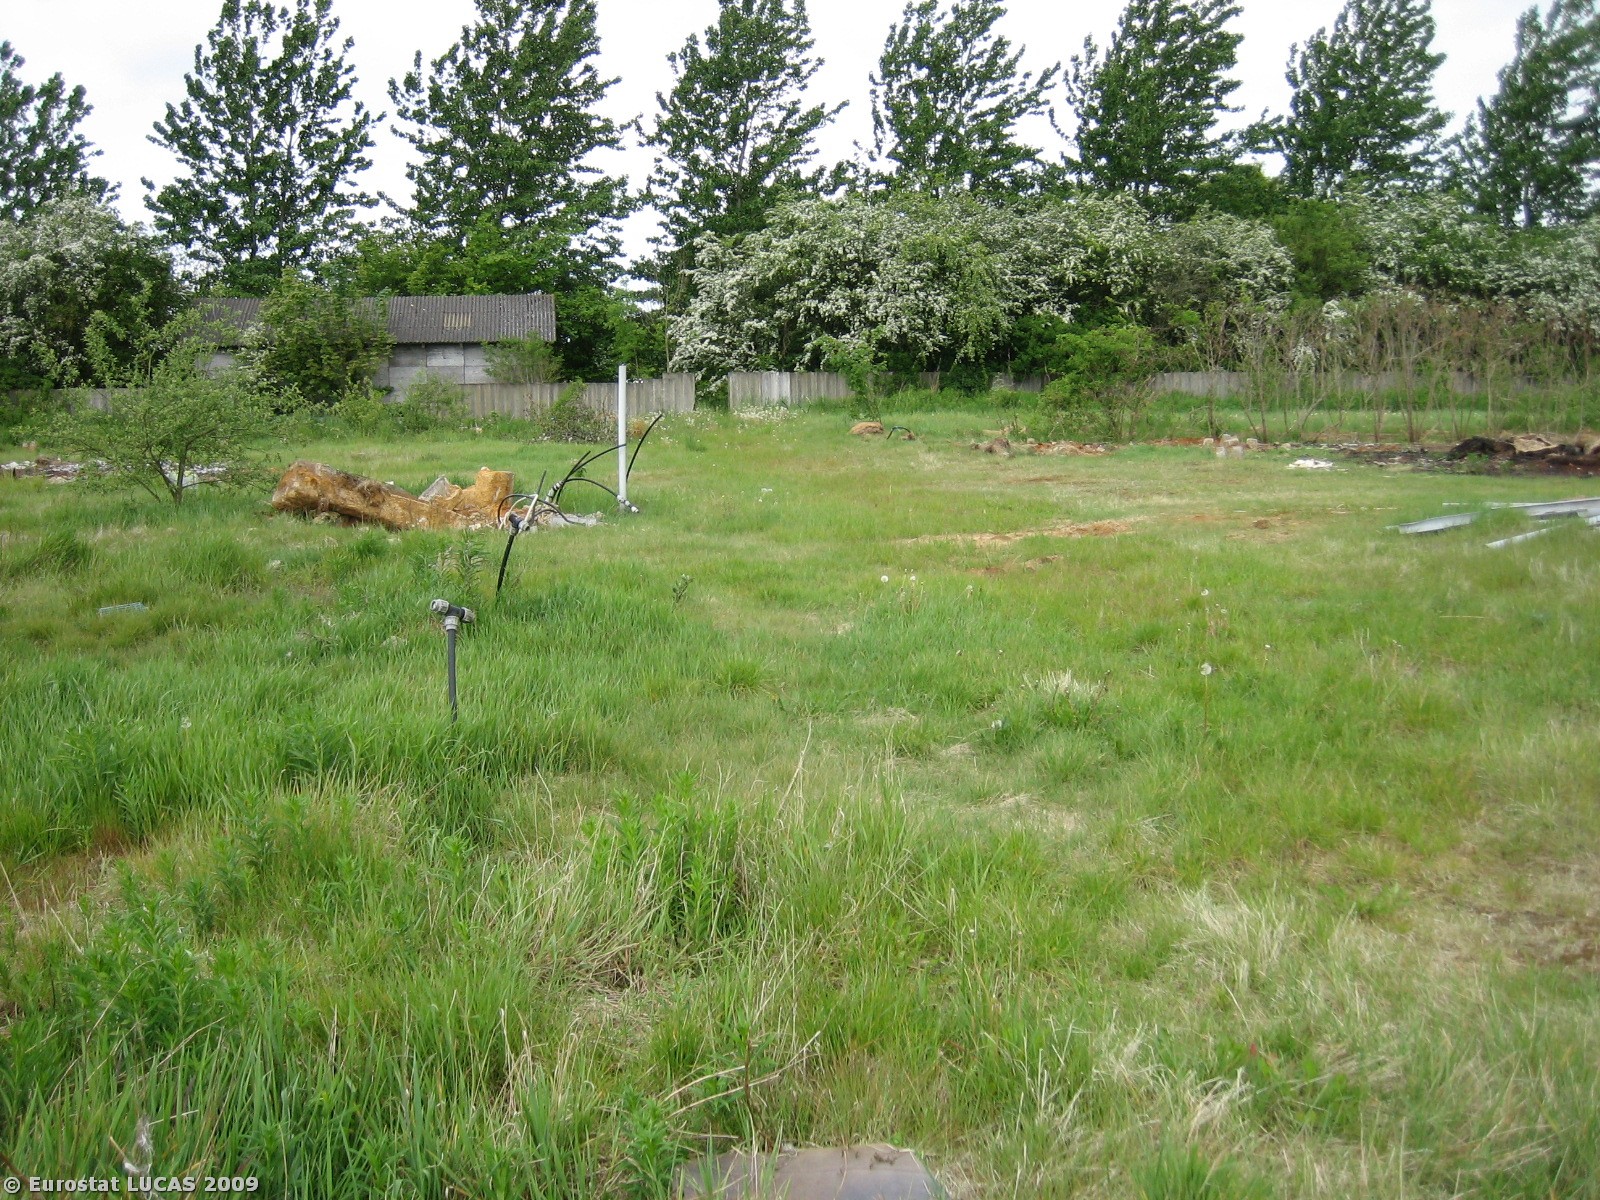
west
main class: Grassland
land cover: Grassland with sparse tree/shrub cover
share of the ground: > 75 %
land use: Logistics and storage
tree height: > 5 m
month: May
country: DK
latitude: 56.0922
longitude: 8.7959
